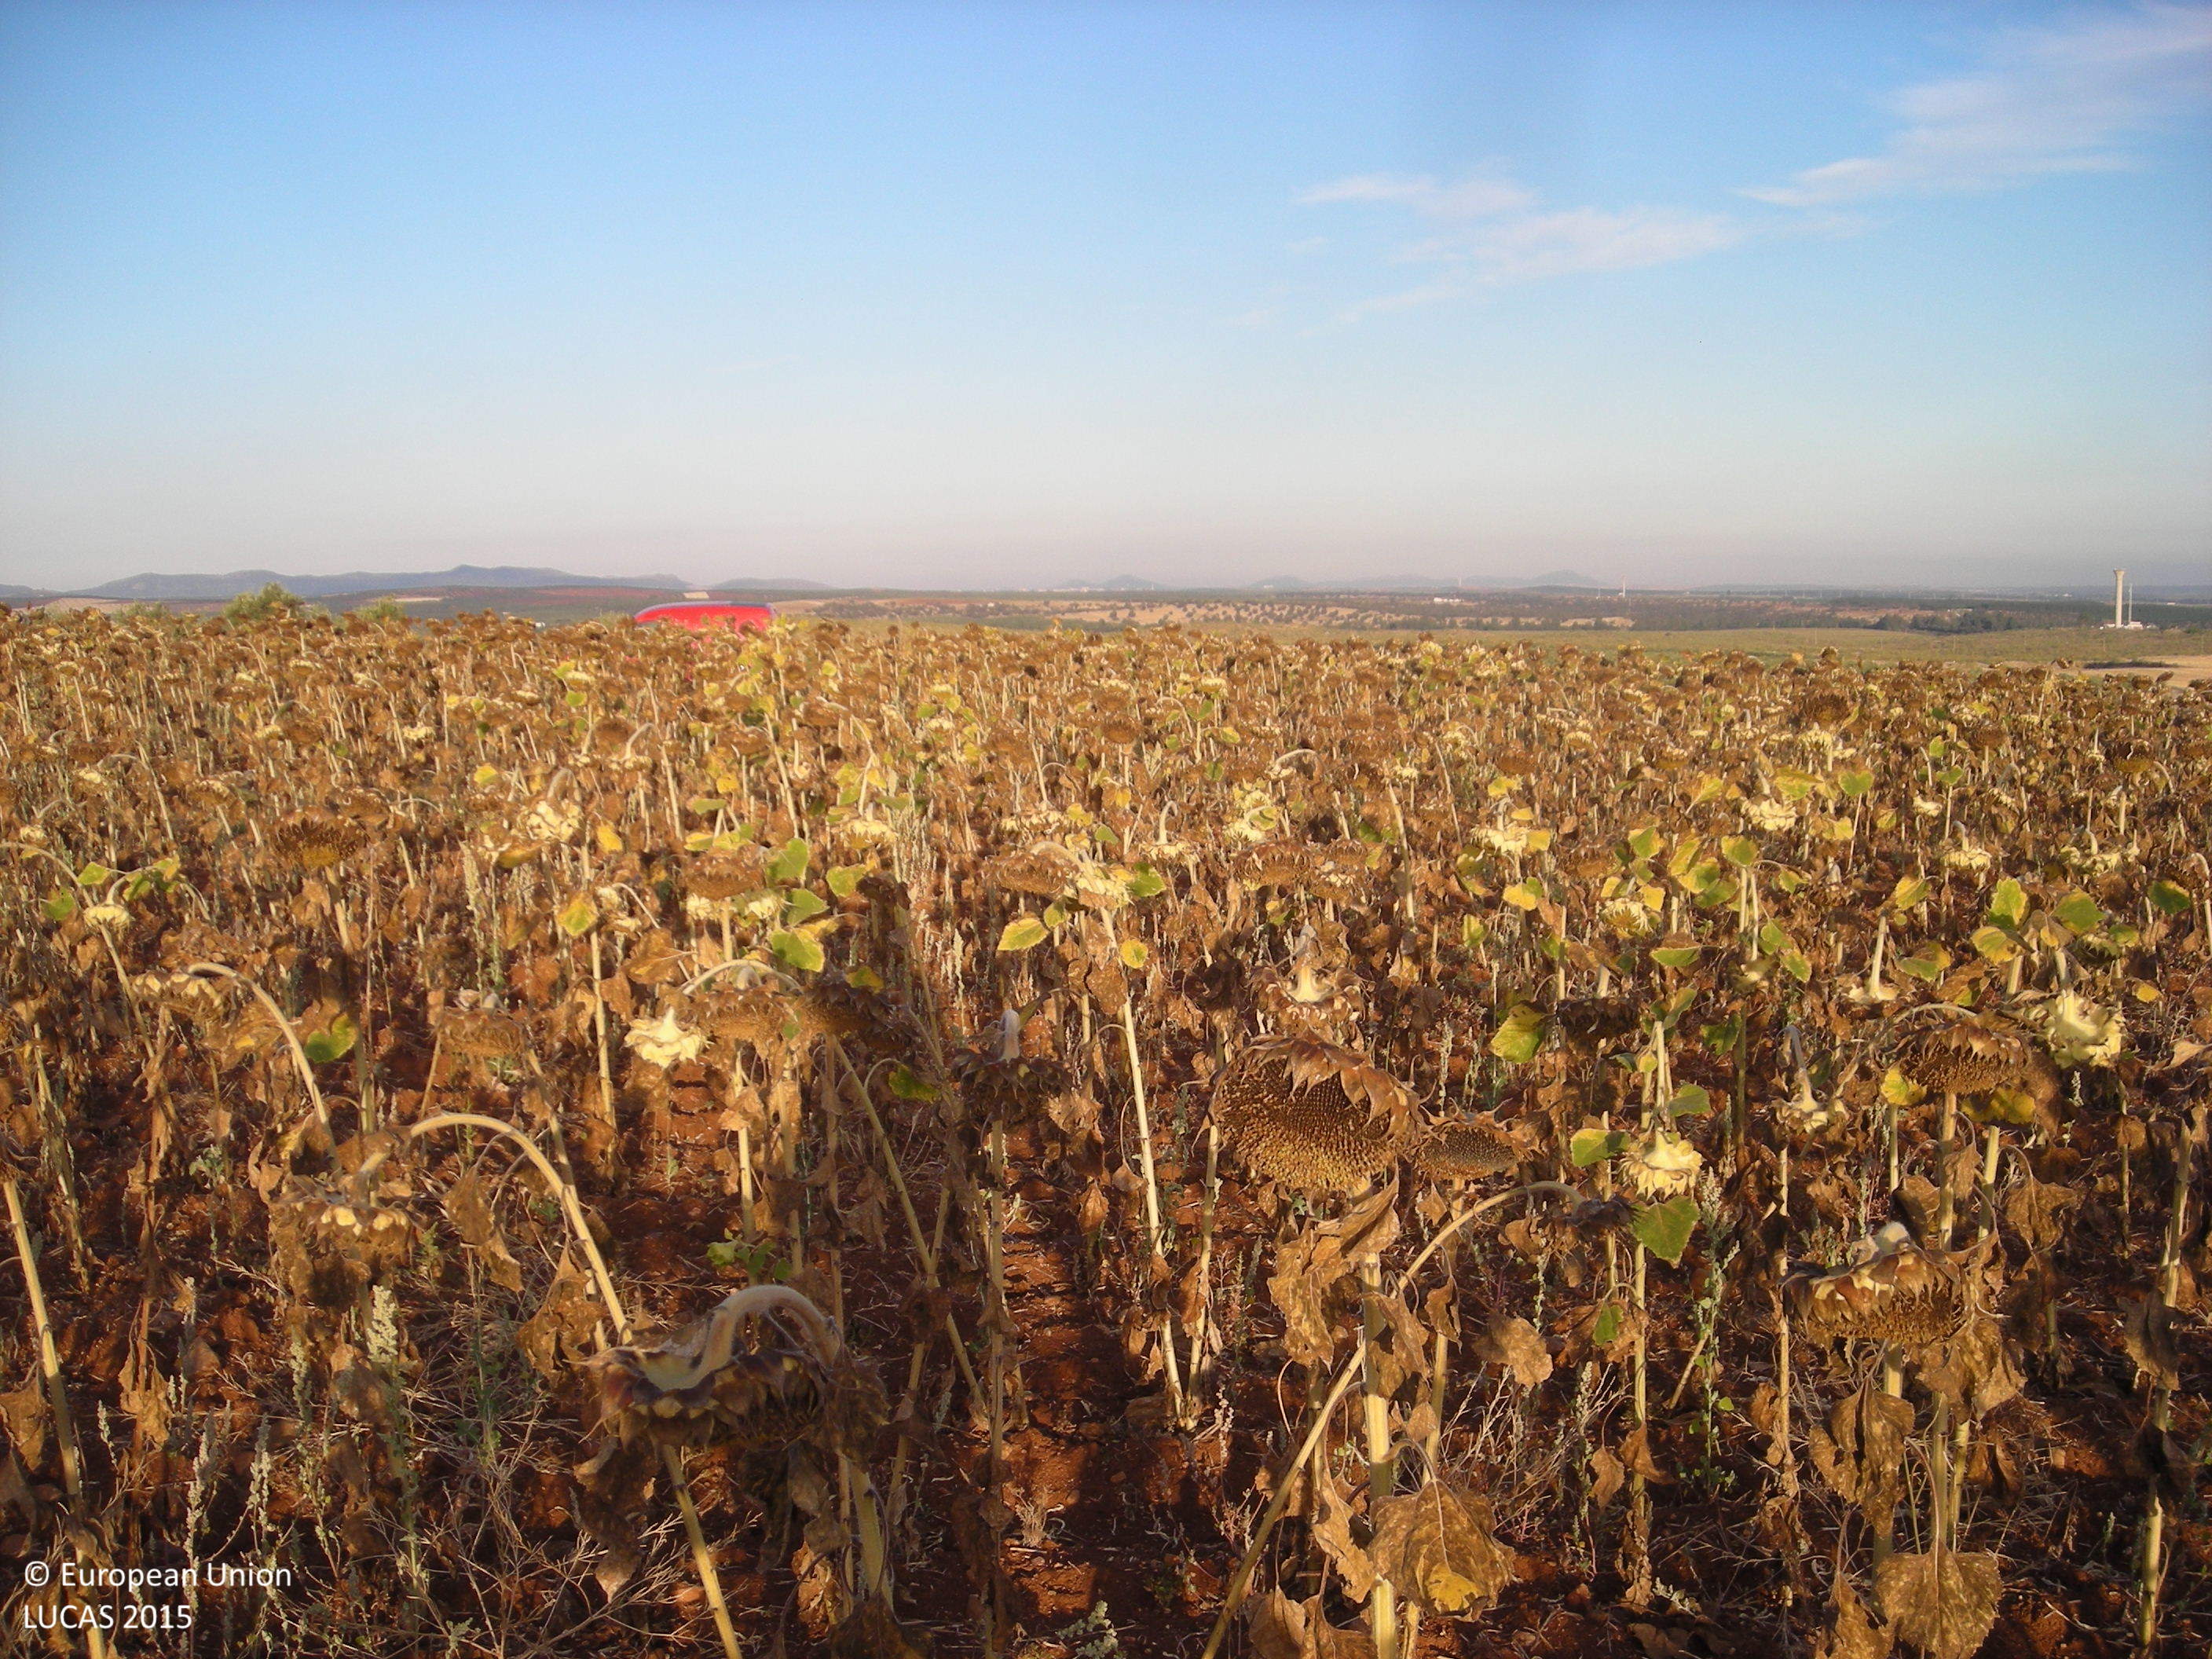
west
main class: Cropland
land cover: Sunflower
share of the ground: > 75 %
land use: Agriculture (excluding fallow land and kitchen gardens)
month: July
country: ES
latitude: 38.8978
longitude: -5.9500
